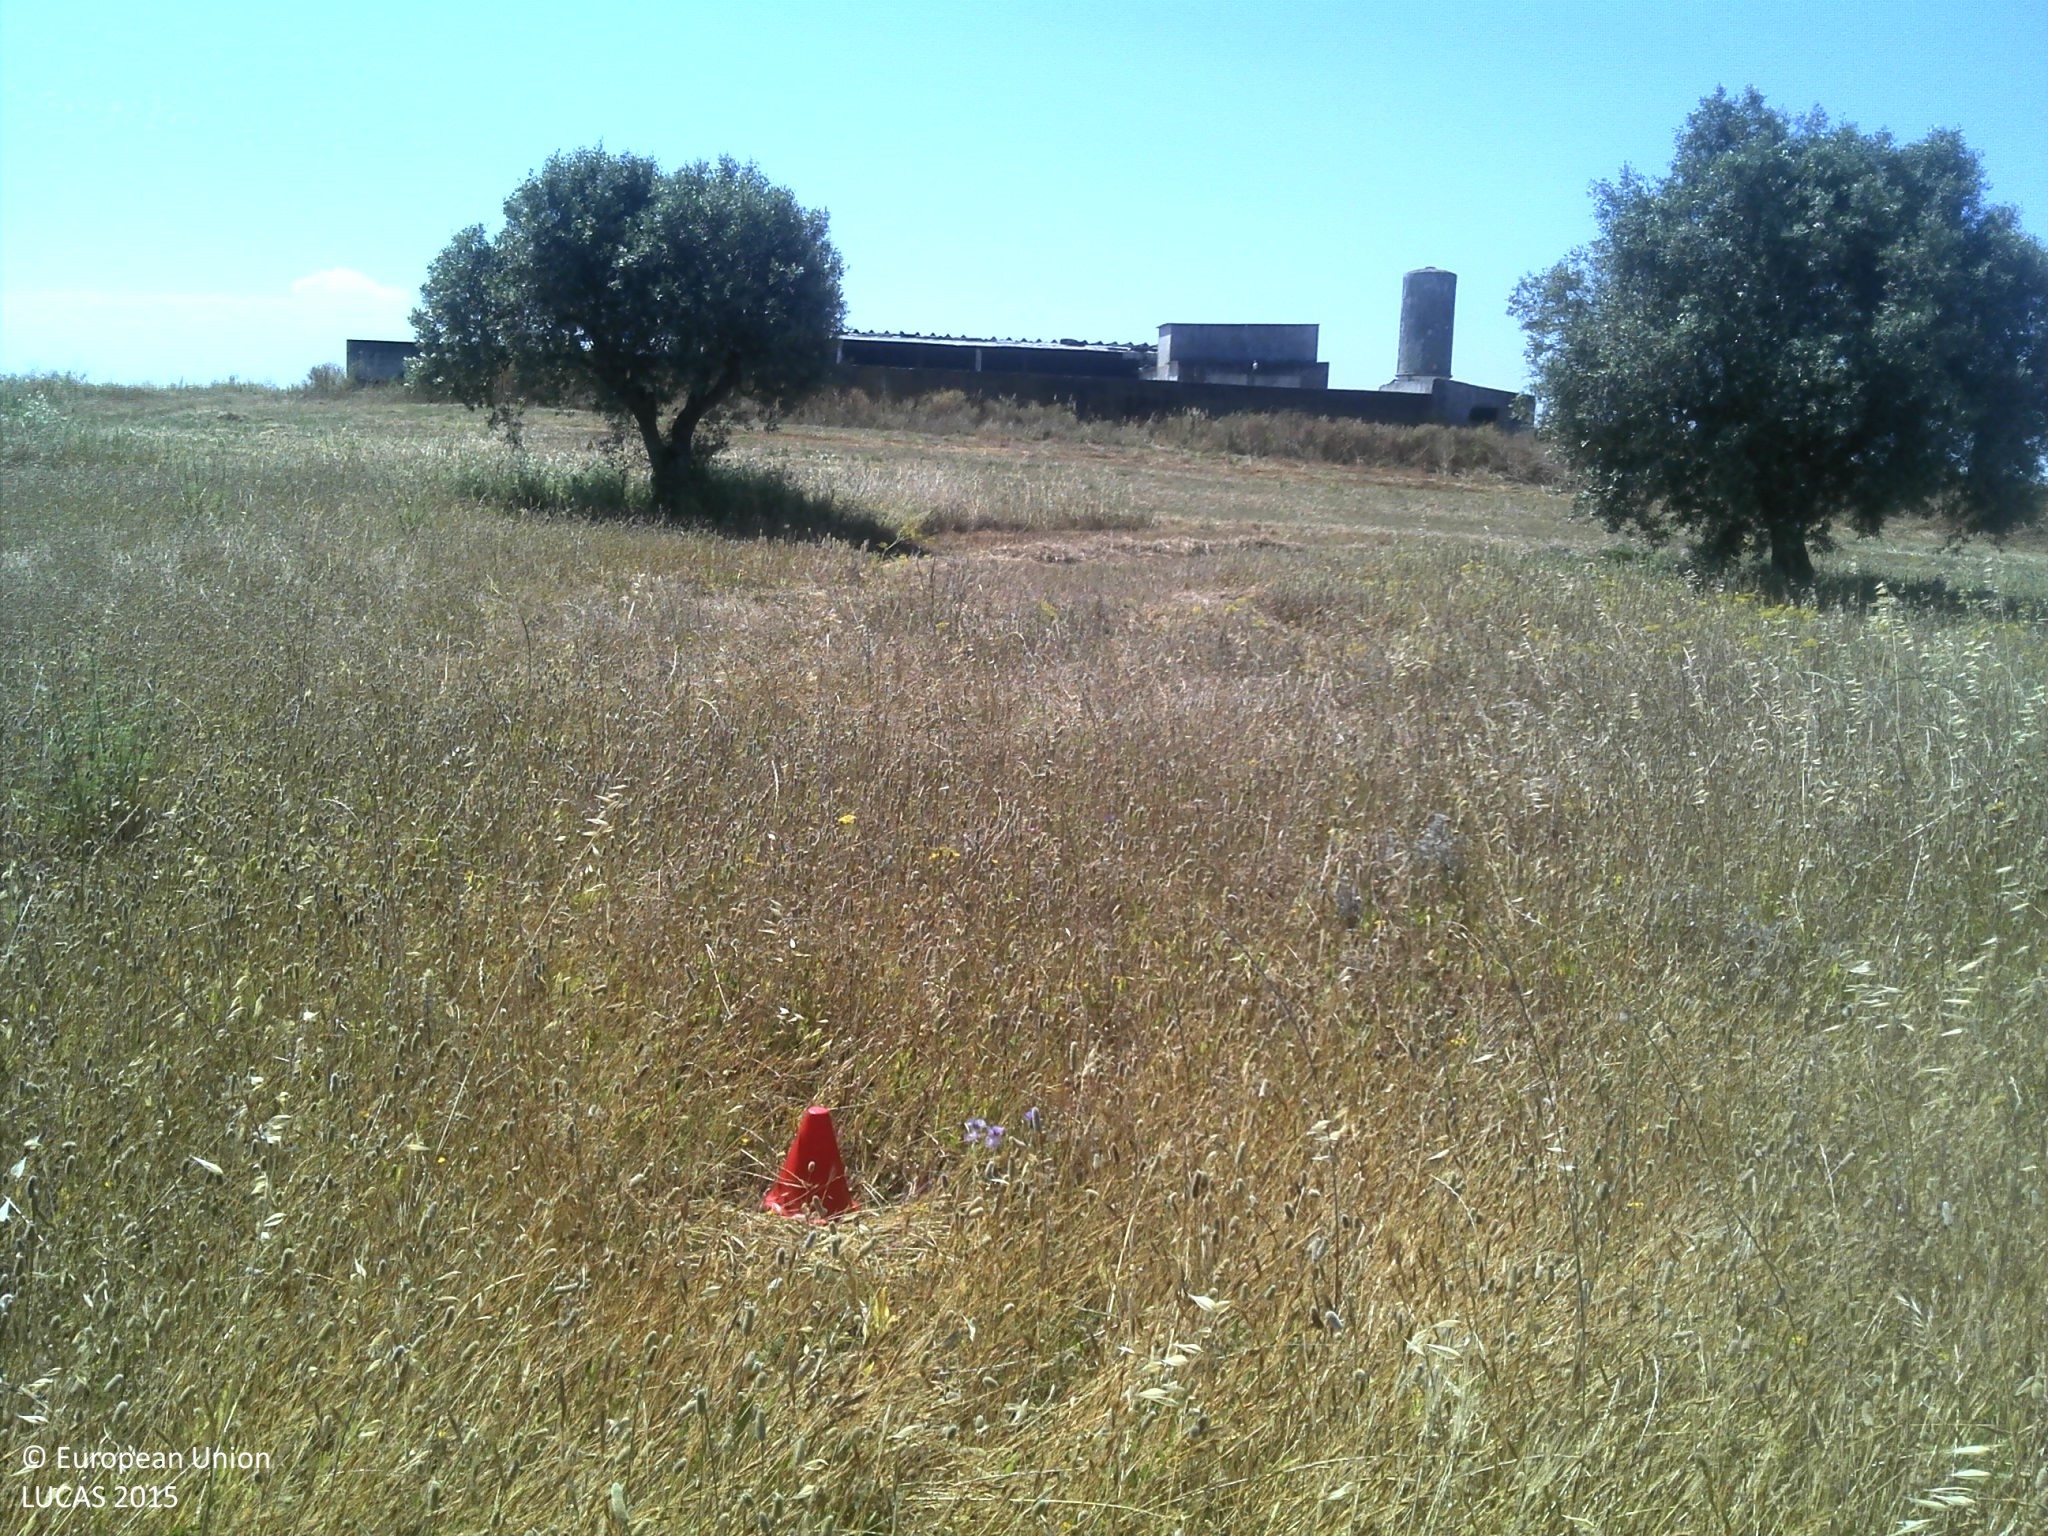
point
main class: Cropland
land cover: Olive groves
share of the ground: 10 - 25 %
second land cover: Grassland without tree/shrub cover
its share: 50 - 75 %
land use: Agriculture (excluding fallow land and kitchen gardens)
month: May
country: PT
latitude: 39.3226
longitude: -8.7872
